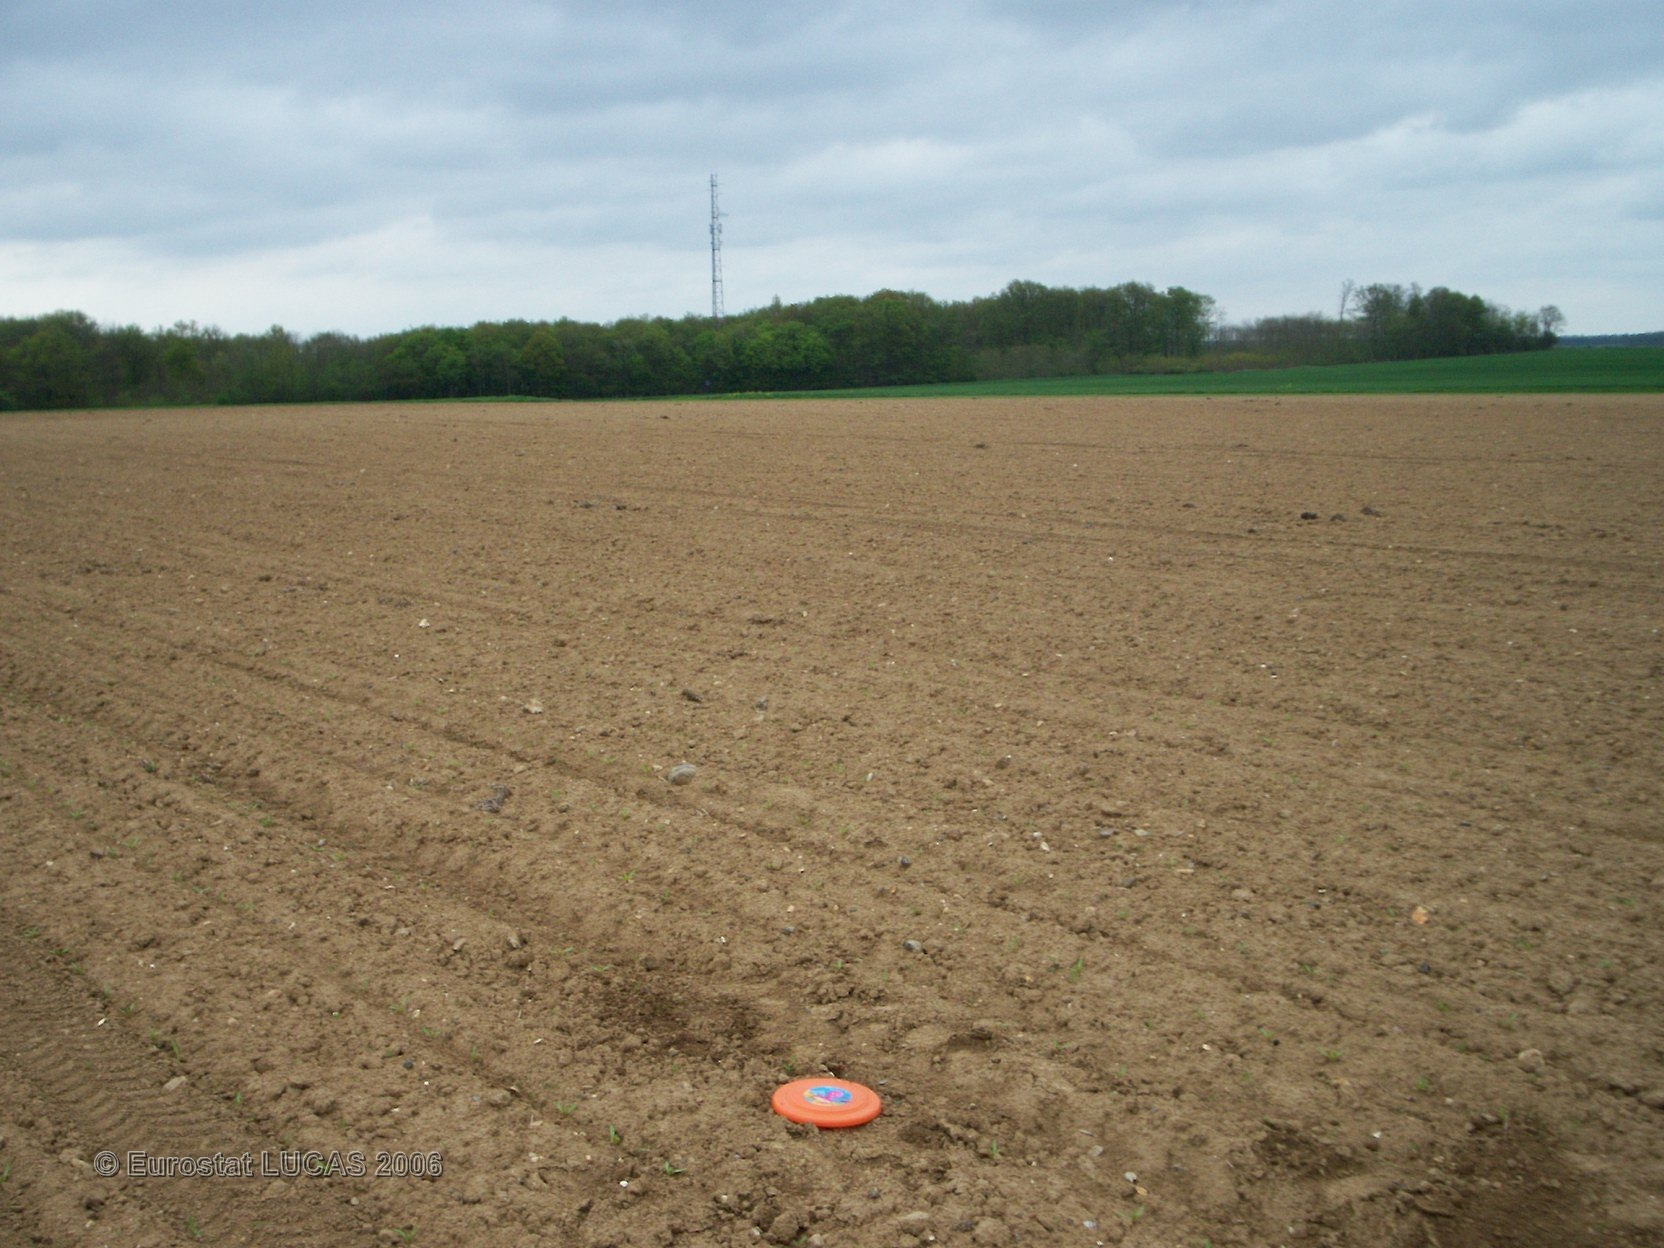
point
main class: Cropland
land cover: Sugar beet
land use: Agriculture (excluding fallow land and kitchen gardens)
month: May
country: FR
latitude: 48.1558
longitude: 2.8807
